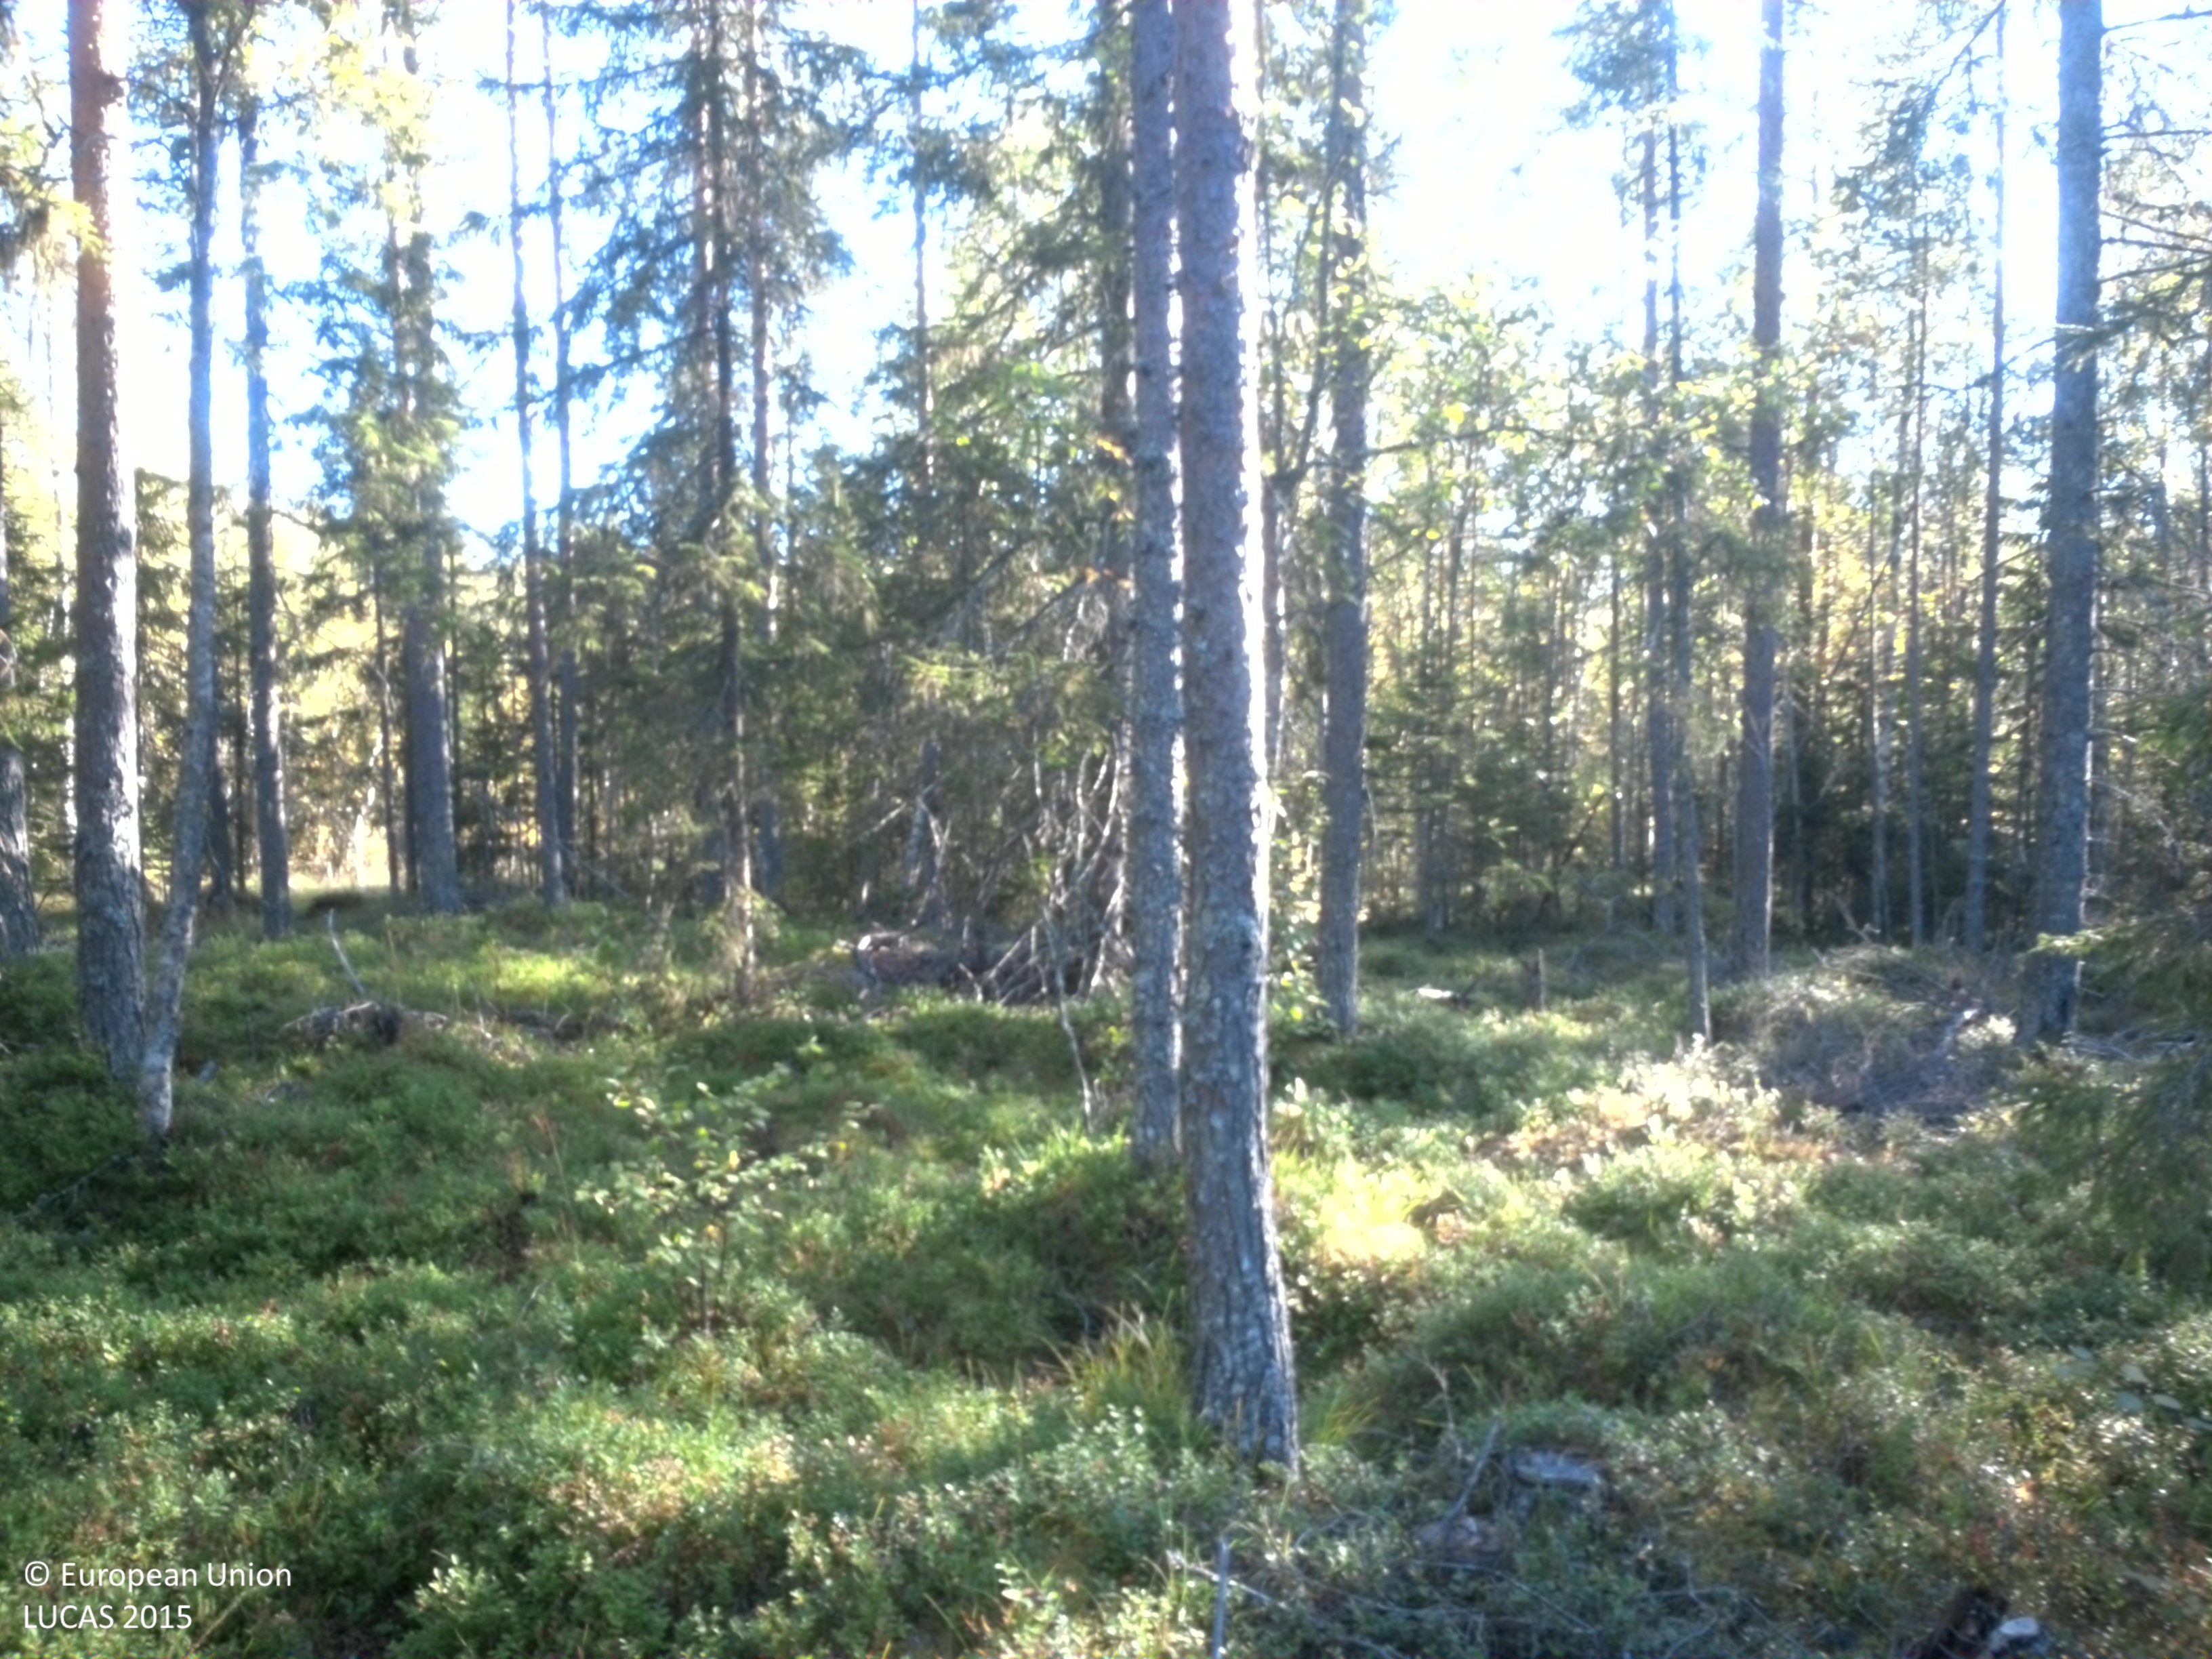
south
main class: Woodland
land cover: Other coniferous woodland
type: boreal forest
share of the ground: 50 - 75 %
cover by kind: coniferous forest trees 45 %, shrubs 35 %, lichens and mosses 10 %, broadleaved forest trees 5 %, herbaceous plants 5 %
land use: Forestry
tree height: > 5 m
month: September
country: SE
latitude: 64.6778
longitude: 19.7991
